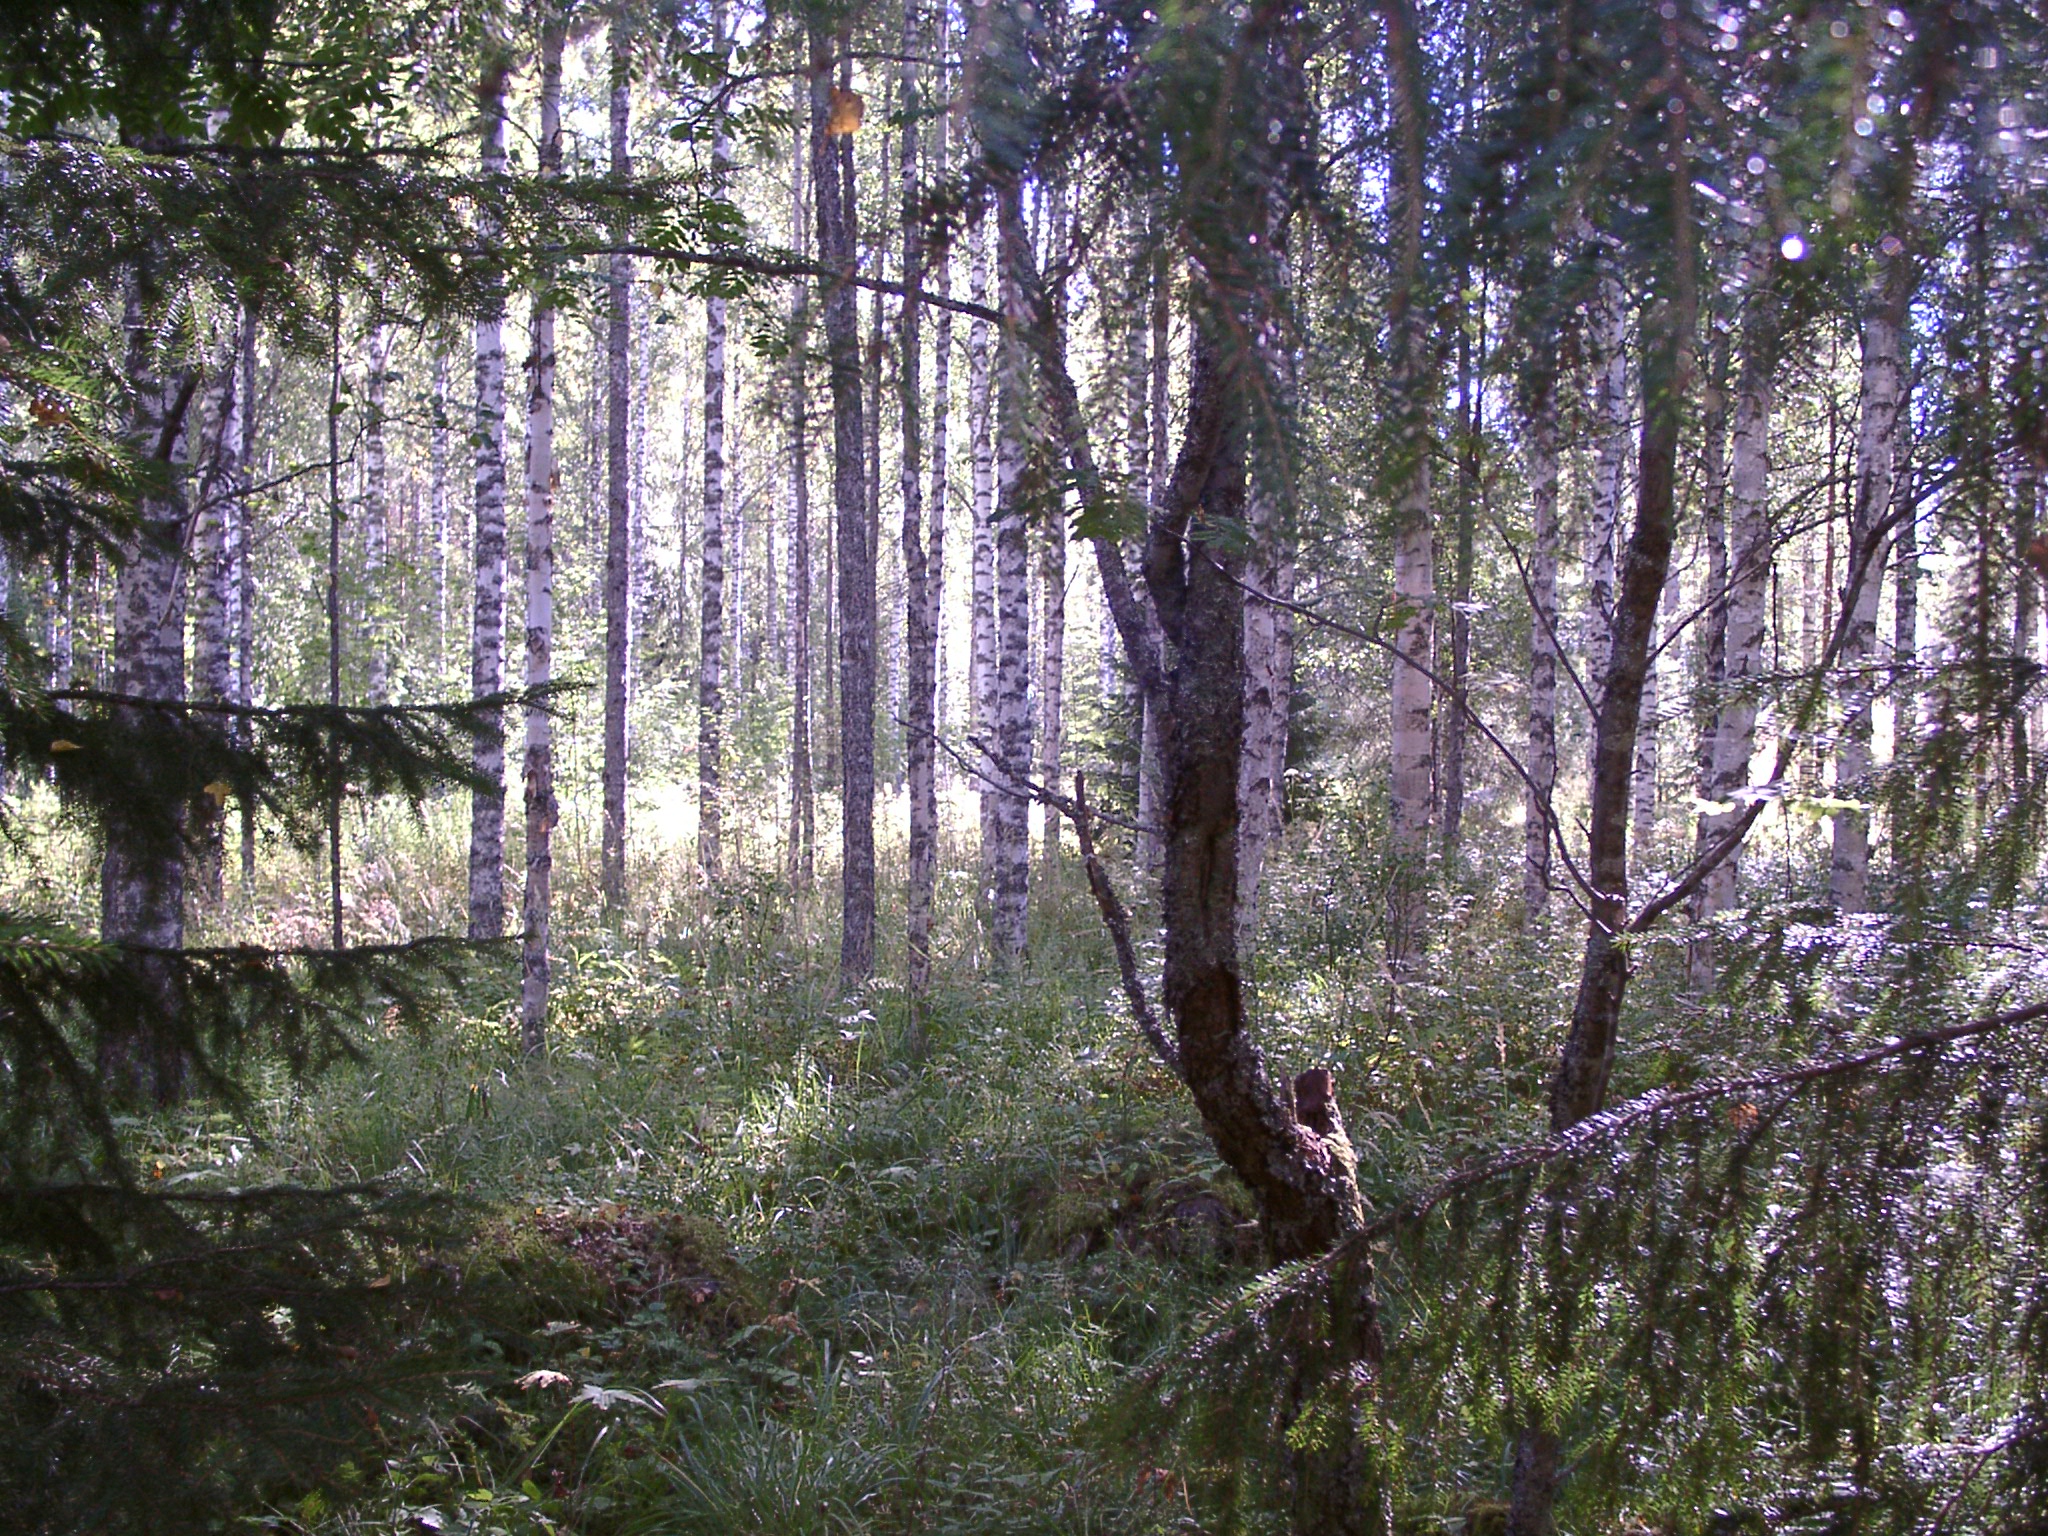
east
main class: Woodland
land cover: Broadleaved woodland
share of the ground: 50 - 75 %
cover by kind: broadleaved forest trees 55 %, herbaceous plants 30 %, coniferous forest trees 15 %
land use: Forestry
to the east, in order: Broadleaved woodland; Grassland with sparse tree/shrub cover; Tracks; Ditches and canals; Electric lines; Broadleaved woodland; Ditches and canals; Broadleaved woodland; Other mixed woodland; Spruce dominated mixed woodland; Other mixed woodland
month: August
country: FI
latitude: 61.9613
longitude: 25.0376
